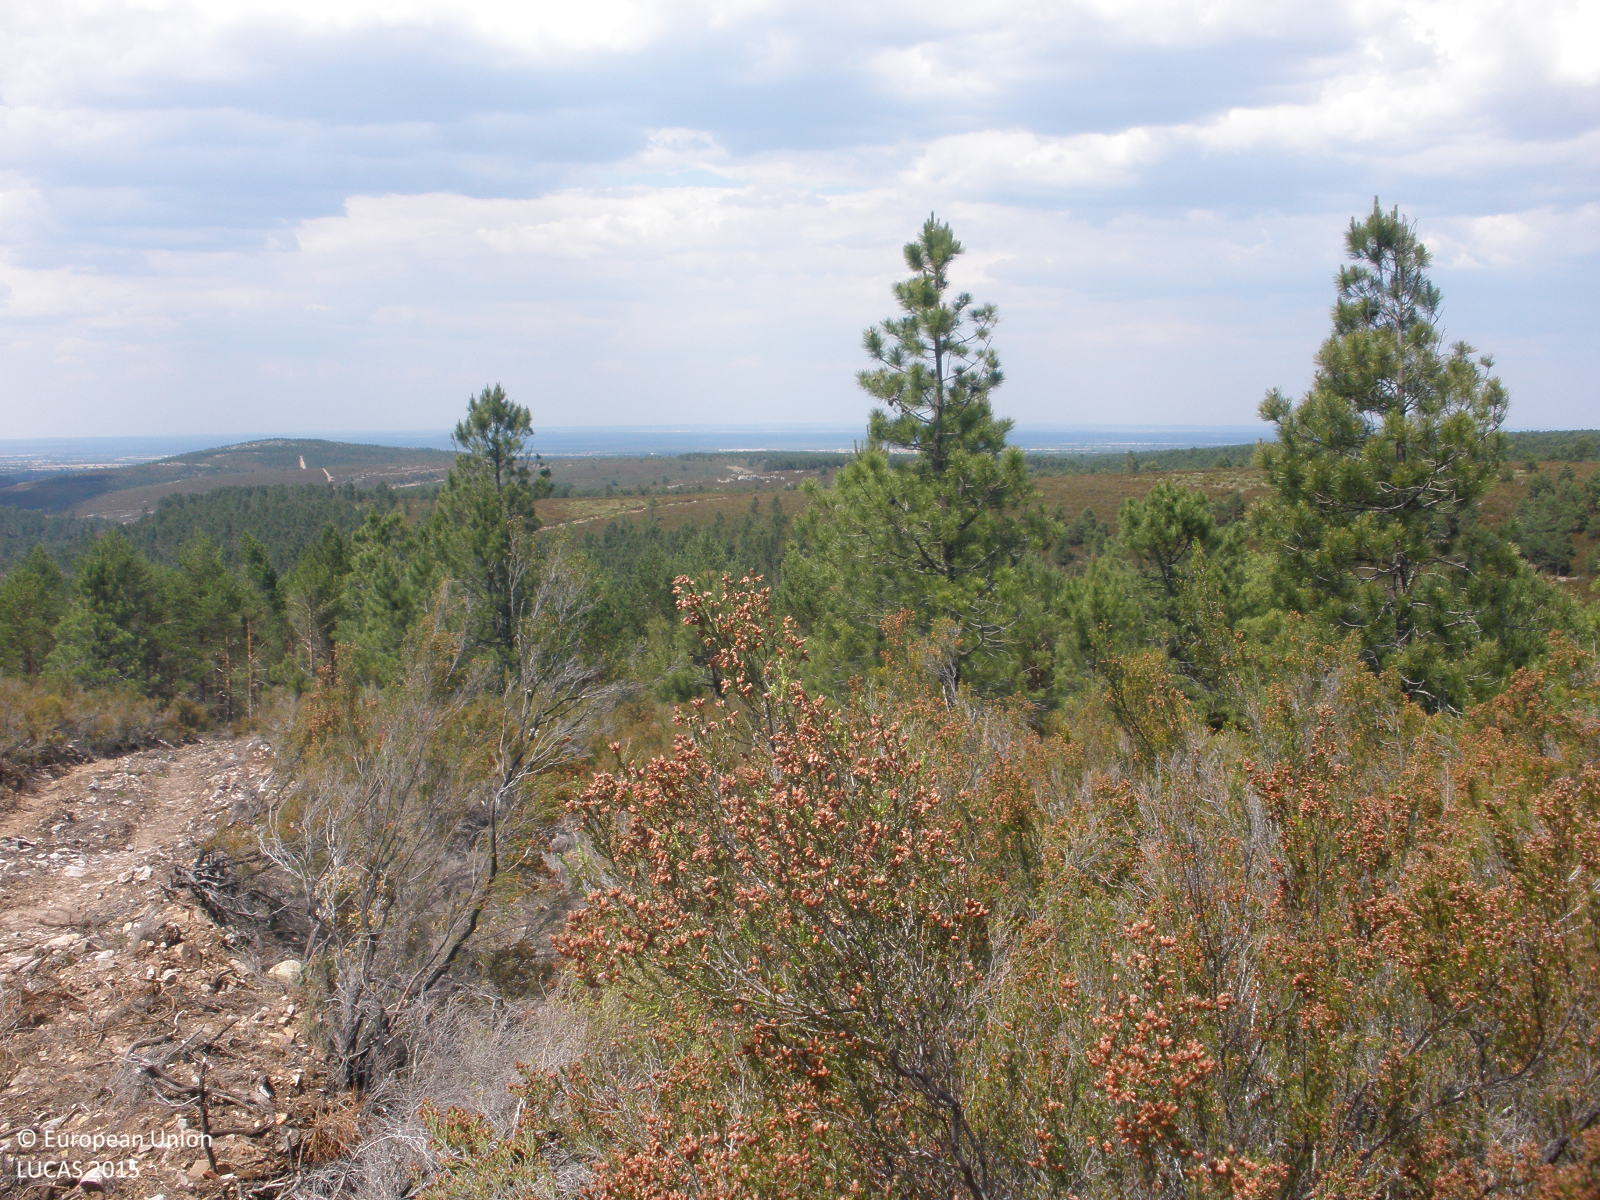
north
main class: Woodland
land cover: Pine dominated coniferous woodland
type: coniferous forest of the mediterranean region
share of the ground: > 75 %
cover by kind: shrubs 80 %, coniferous forest trees 20 %
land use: Forestry
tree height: > 5 m
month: June
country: ES
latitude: 40.5373
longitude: -6.2696
